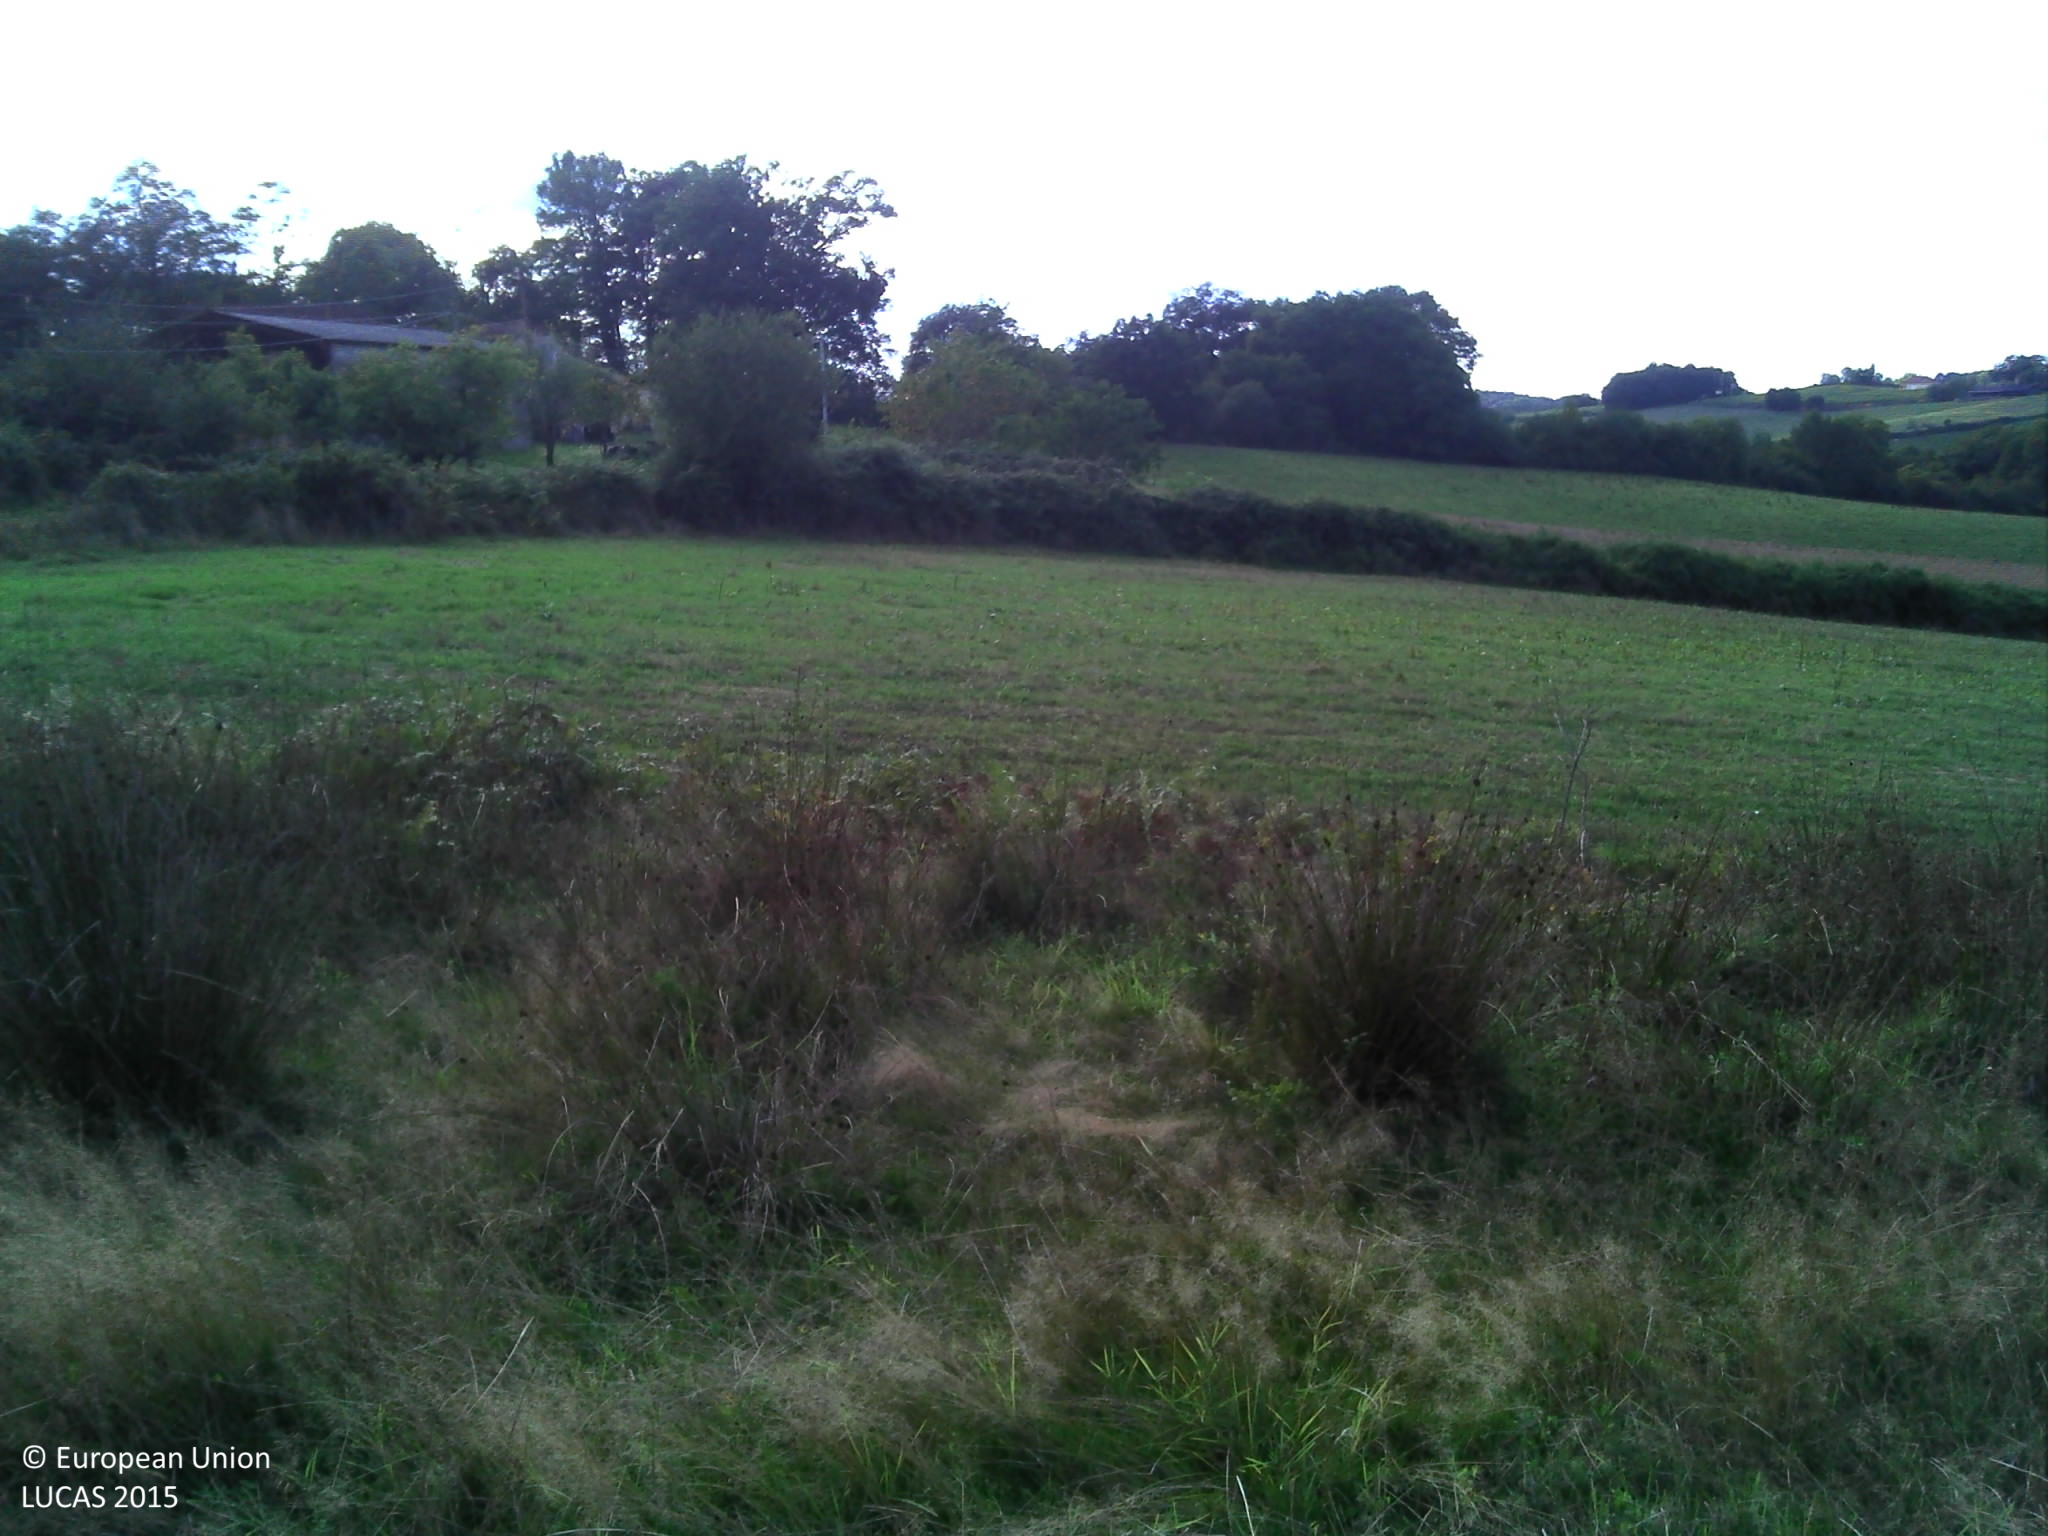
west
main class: Grassland
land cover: Grassland without tree/shrub cover
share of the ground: > 75 %
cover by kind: herbaceous plants 100 %
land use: Agriculture (excluding fallow land and kitchen gardens)
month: September
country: FR
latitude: 43.5216
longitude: -0.5382
